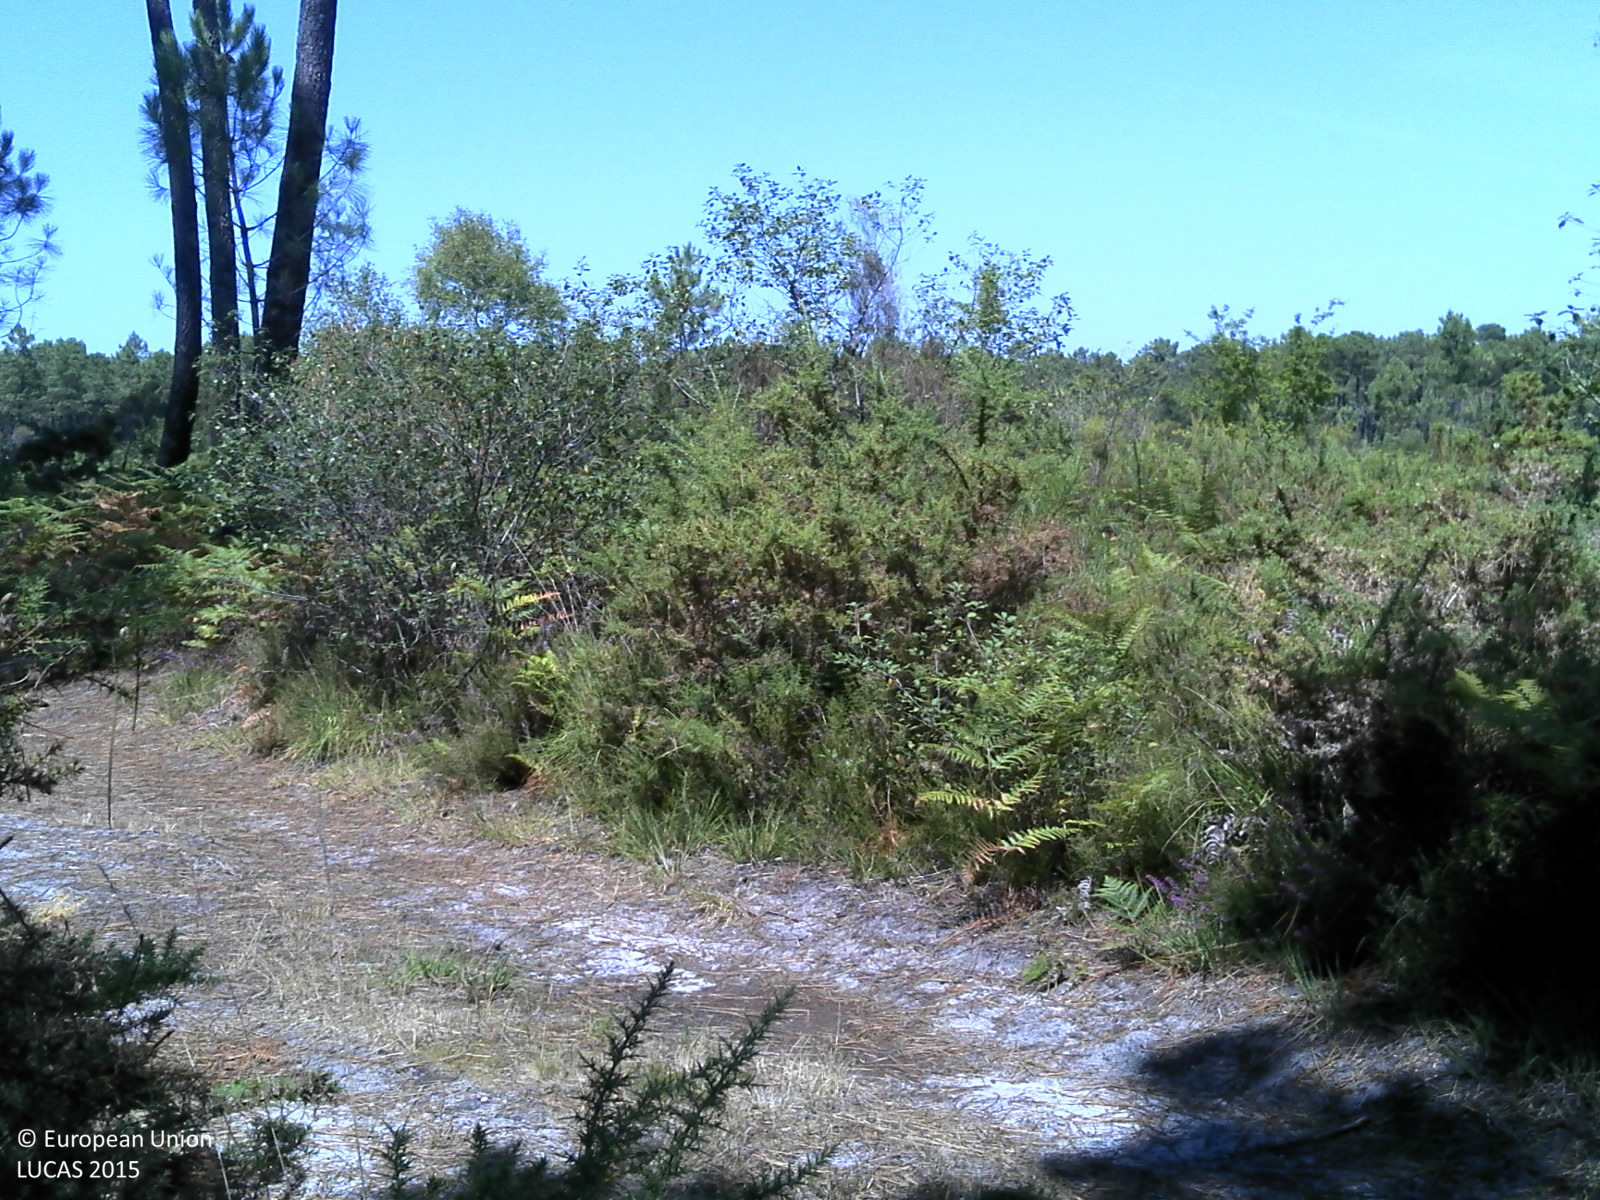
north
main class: Woodland
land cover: Pine dominated coniferous woodland
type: exotic forest
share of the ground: > 75 %
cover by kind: coniferous forest trees 60 %, shrubs 30 %, herbaceous plants 5 %, lichens and mosses 5 %
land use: Forestry
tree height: > 5 m
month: August
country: FR
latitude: 44.4822
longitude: -0.5651
